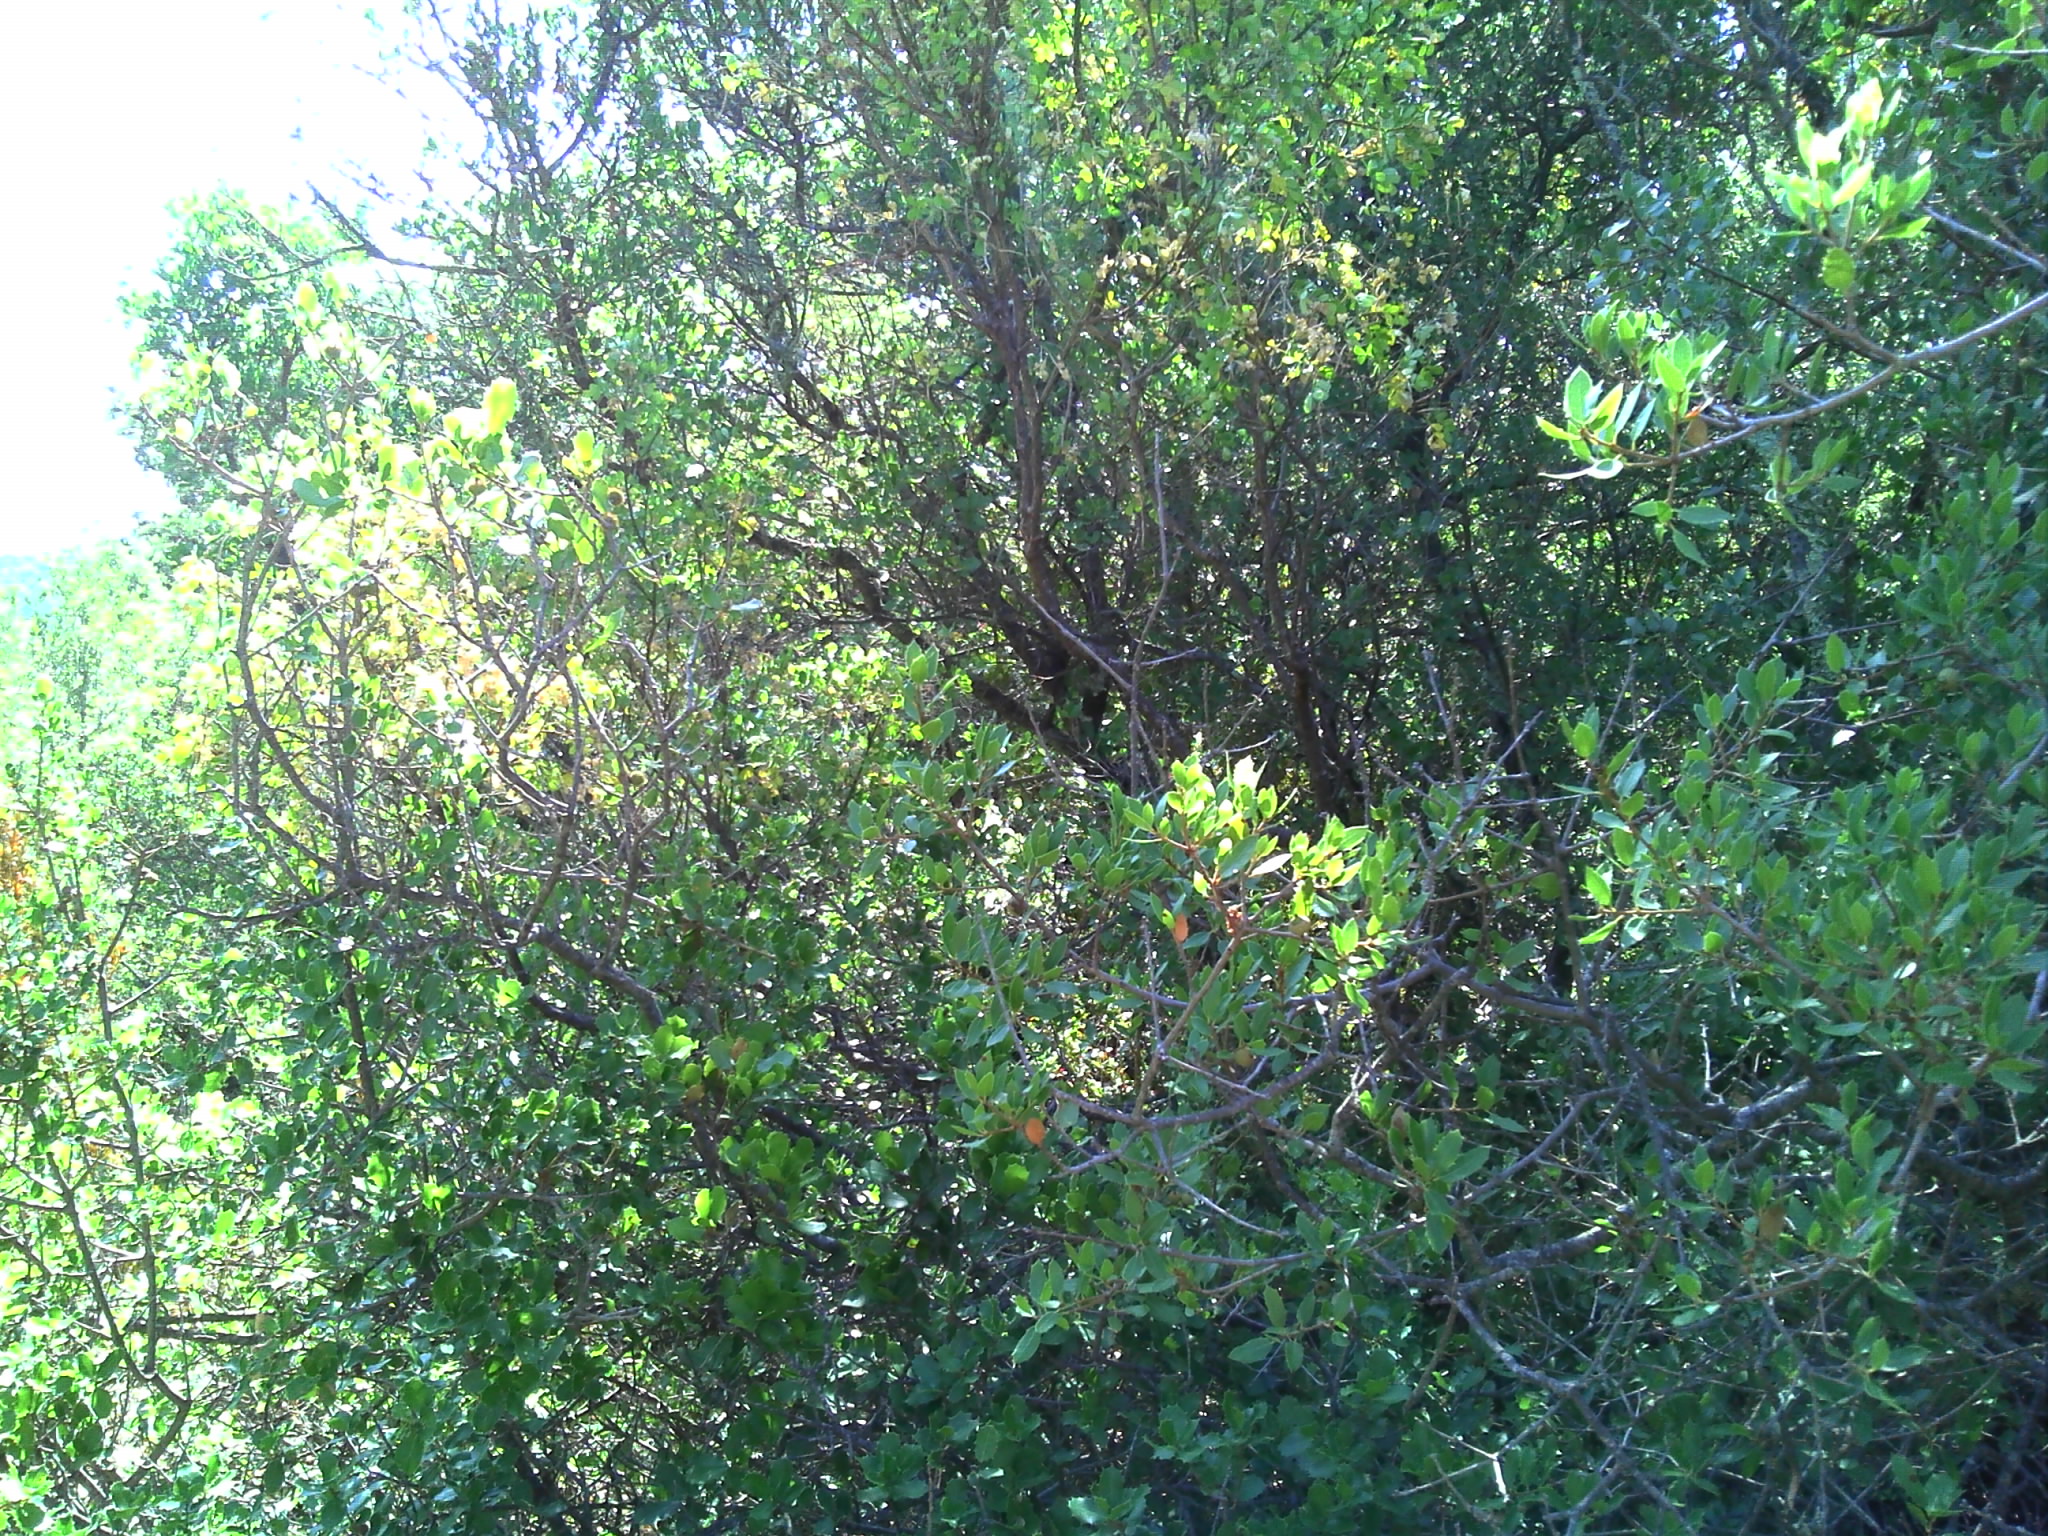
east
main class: Woodland
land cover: Broadleaved woodland
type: broadleaved evergreen forest
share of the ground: > 75 %
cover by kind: broadleaved forest trees 60 %, shrubs 20 %, herbaceous plants 10 %, consolidated bare surface 10 %
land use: Semi-natural and natural areas not in use
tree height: > 5 m
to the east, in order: Broadleaved woodland; Pine dominated mixed woodland; Tracks; Grass margins; Ditches and canals; Vineyards; Olive groves; Spontaneously vegetated surfaces; Olive groves; Abandoned hedges; Ditches and canals; Grass margins; Vineyards
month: July
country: FR
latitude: 44.0495
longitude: 4.3041
